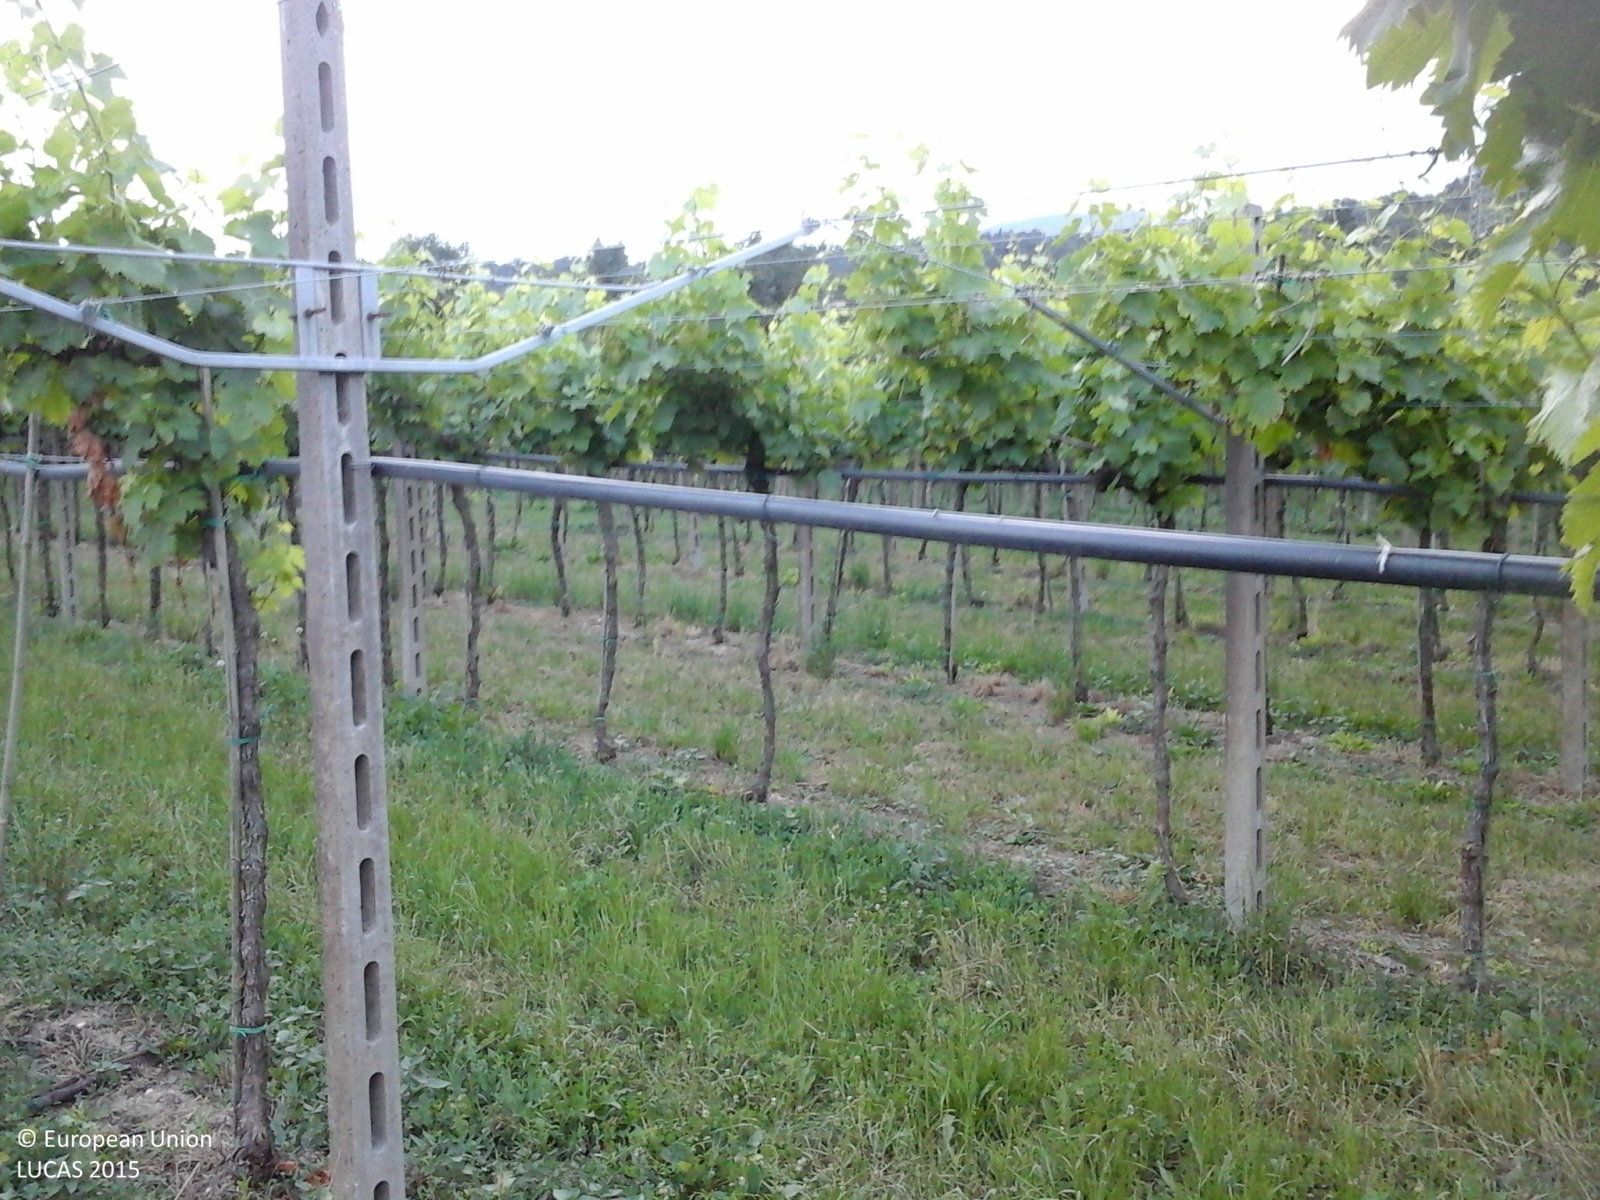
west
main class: Cropland
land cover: Vineyards
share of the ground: 50 - 75 %
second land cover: Grassland without tree/shrub cover
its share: > 75 %
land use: Agriculture (excluding fallow land and kitchen gardens)
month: June
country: IT
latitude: 45.5914
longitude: 10.8062
